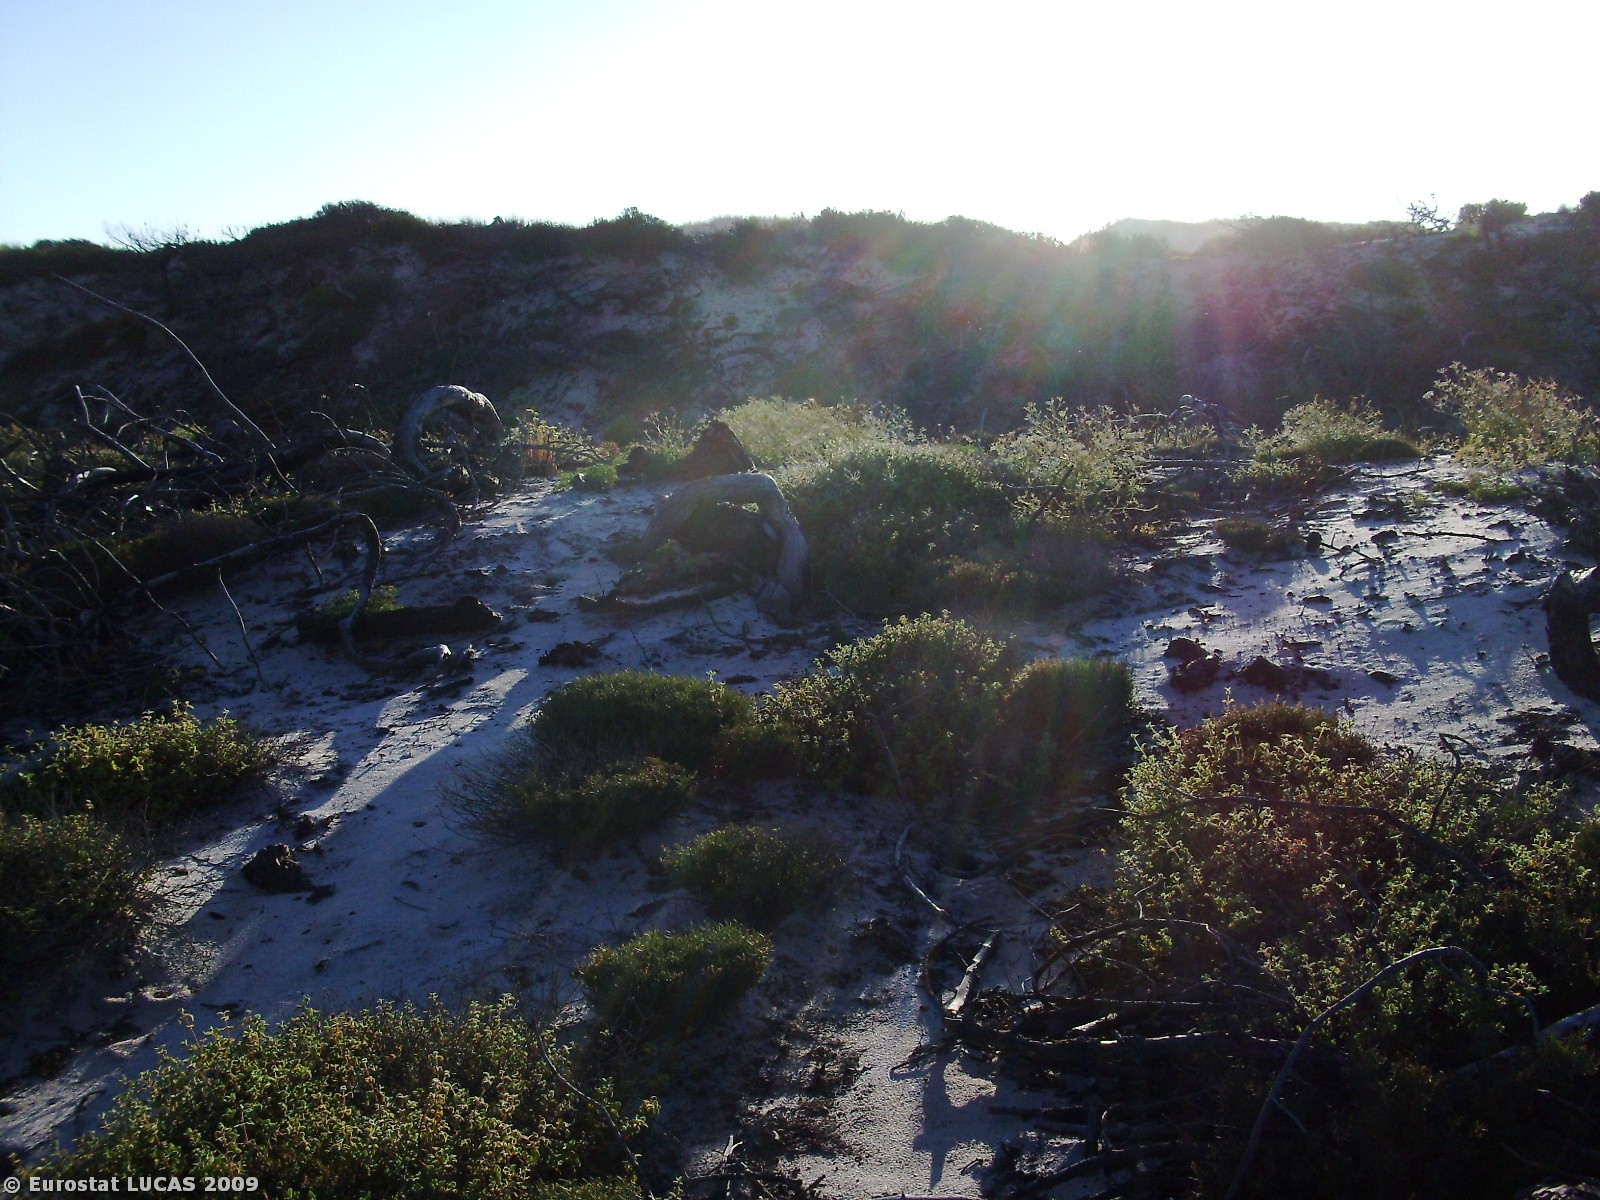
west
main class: Grassland
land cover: Spontaneously vegetated surfaces
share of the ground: 50 - 75 %
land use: Nature reserves
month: July
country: PT
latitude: 39.8383
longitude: -8.9888
